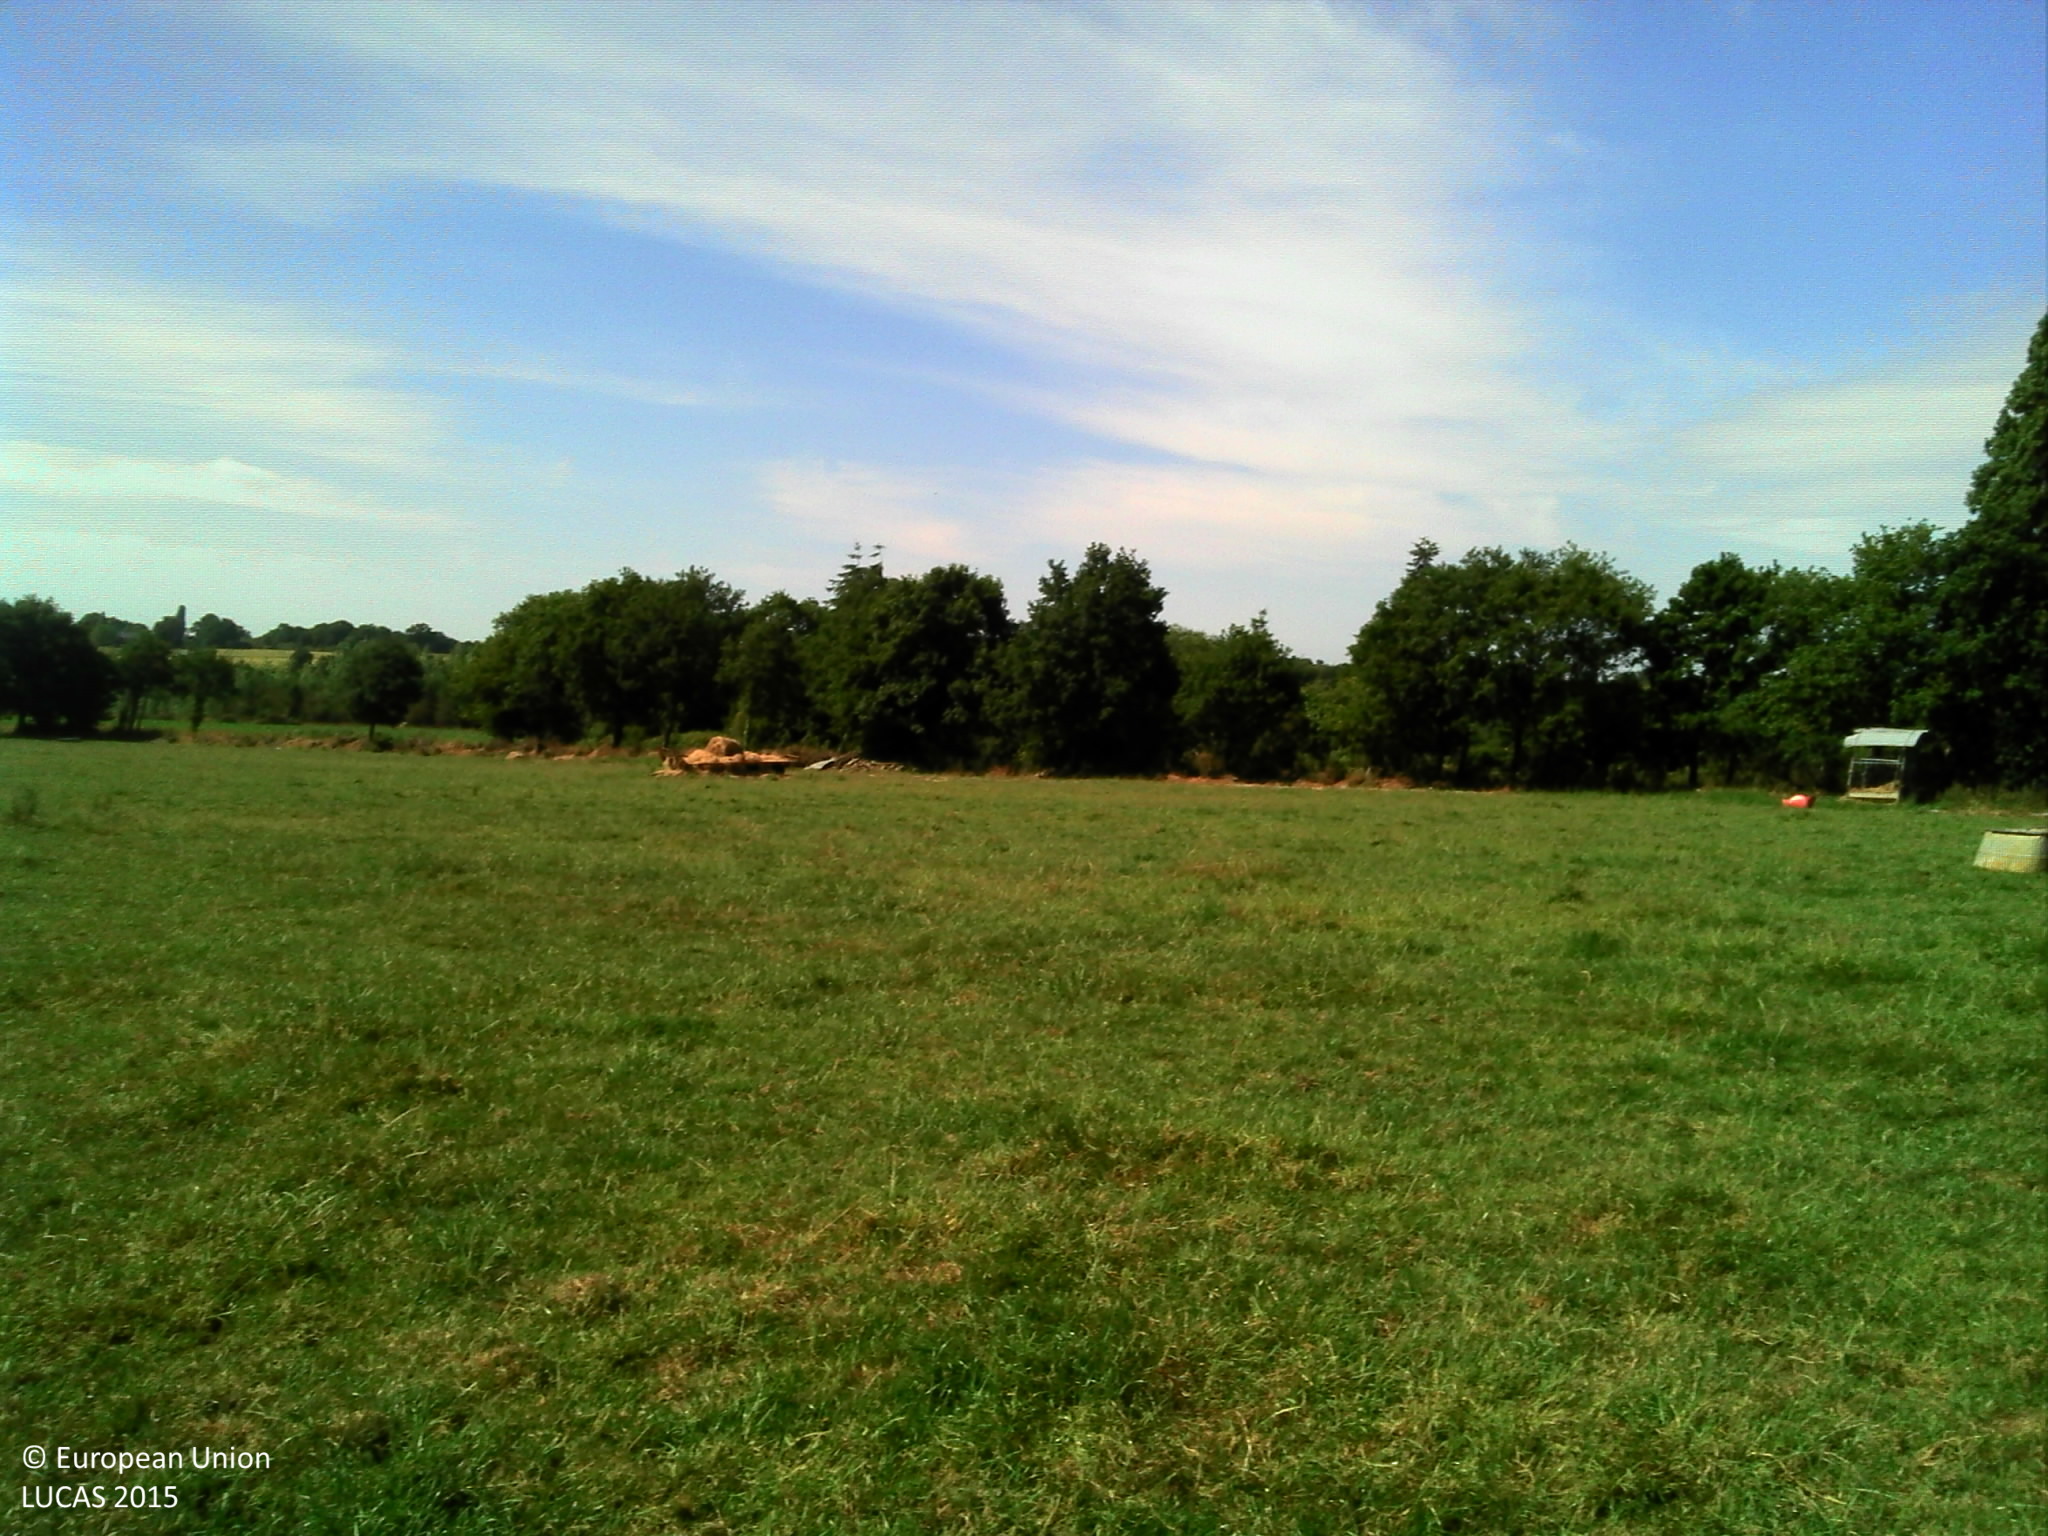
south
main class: Grassland
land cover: Grassland without tree/shrub cover
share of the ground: > 75 %
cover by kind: herbaceous plants 100 %
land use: Agriculture (excluding fallow land and kitchen gardens)
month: June
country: FR
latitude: 47.9760
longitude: -2.0695
